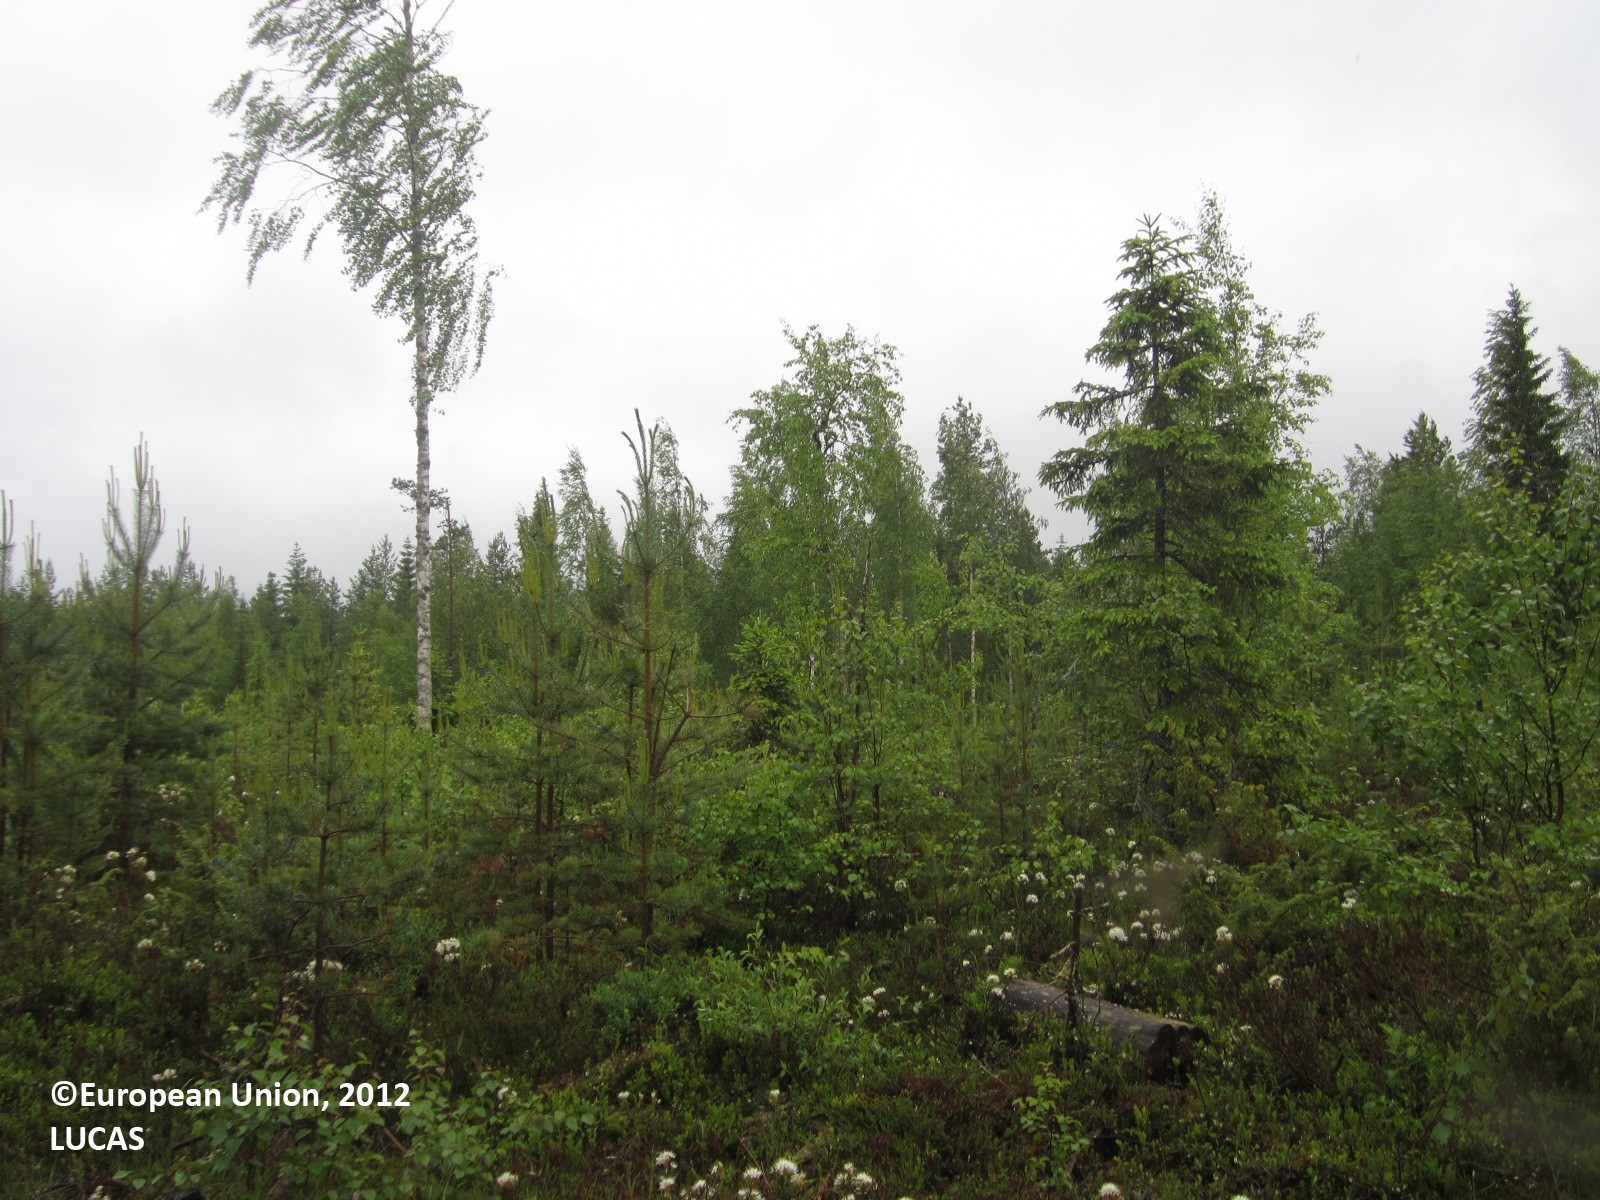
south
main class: Woodland
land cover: Pine dominated mixed woodland
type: boreal forest
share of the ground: 50 - 75 %
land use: Forestry
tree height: > 5 m
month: June
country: FI
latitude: 64.3298
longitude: 29.6497
